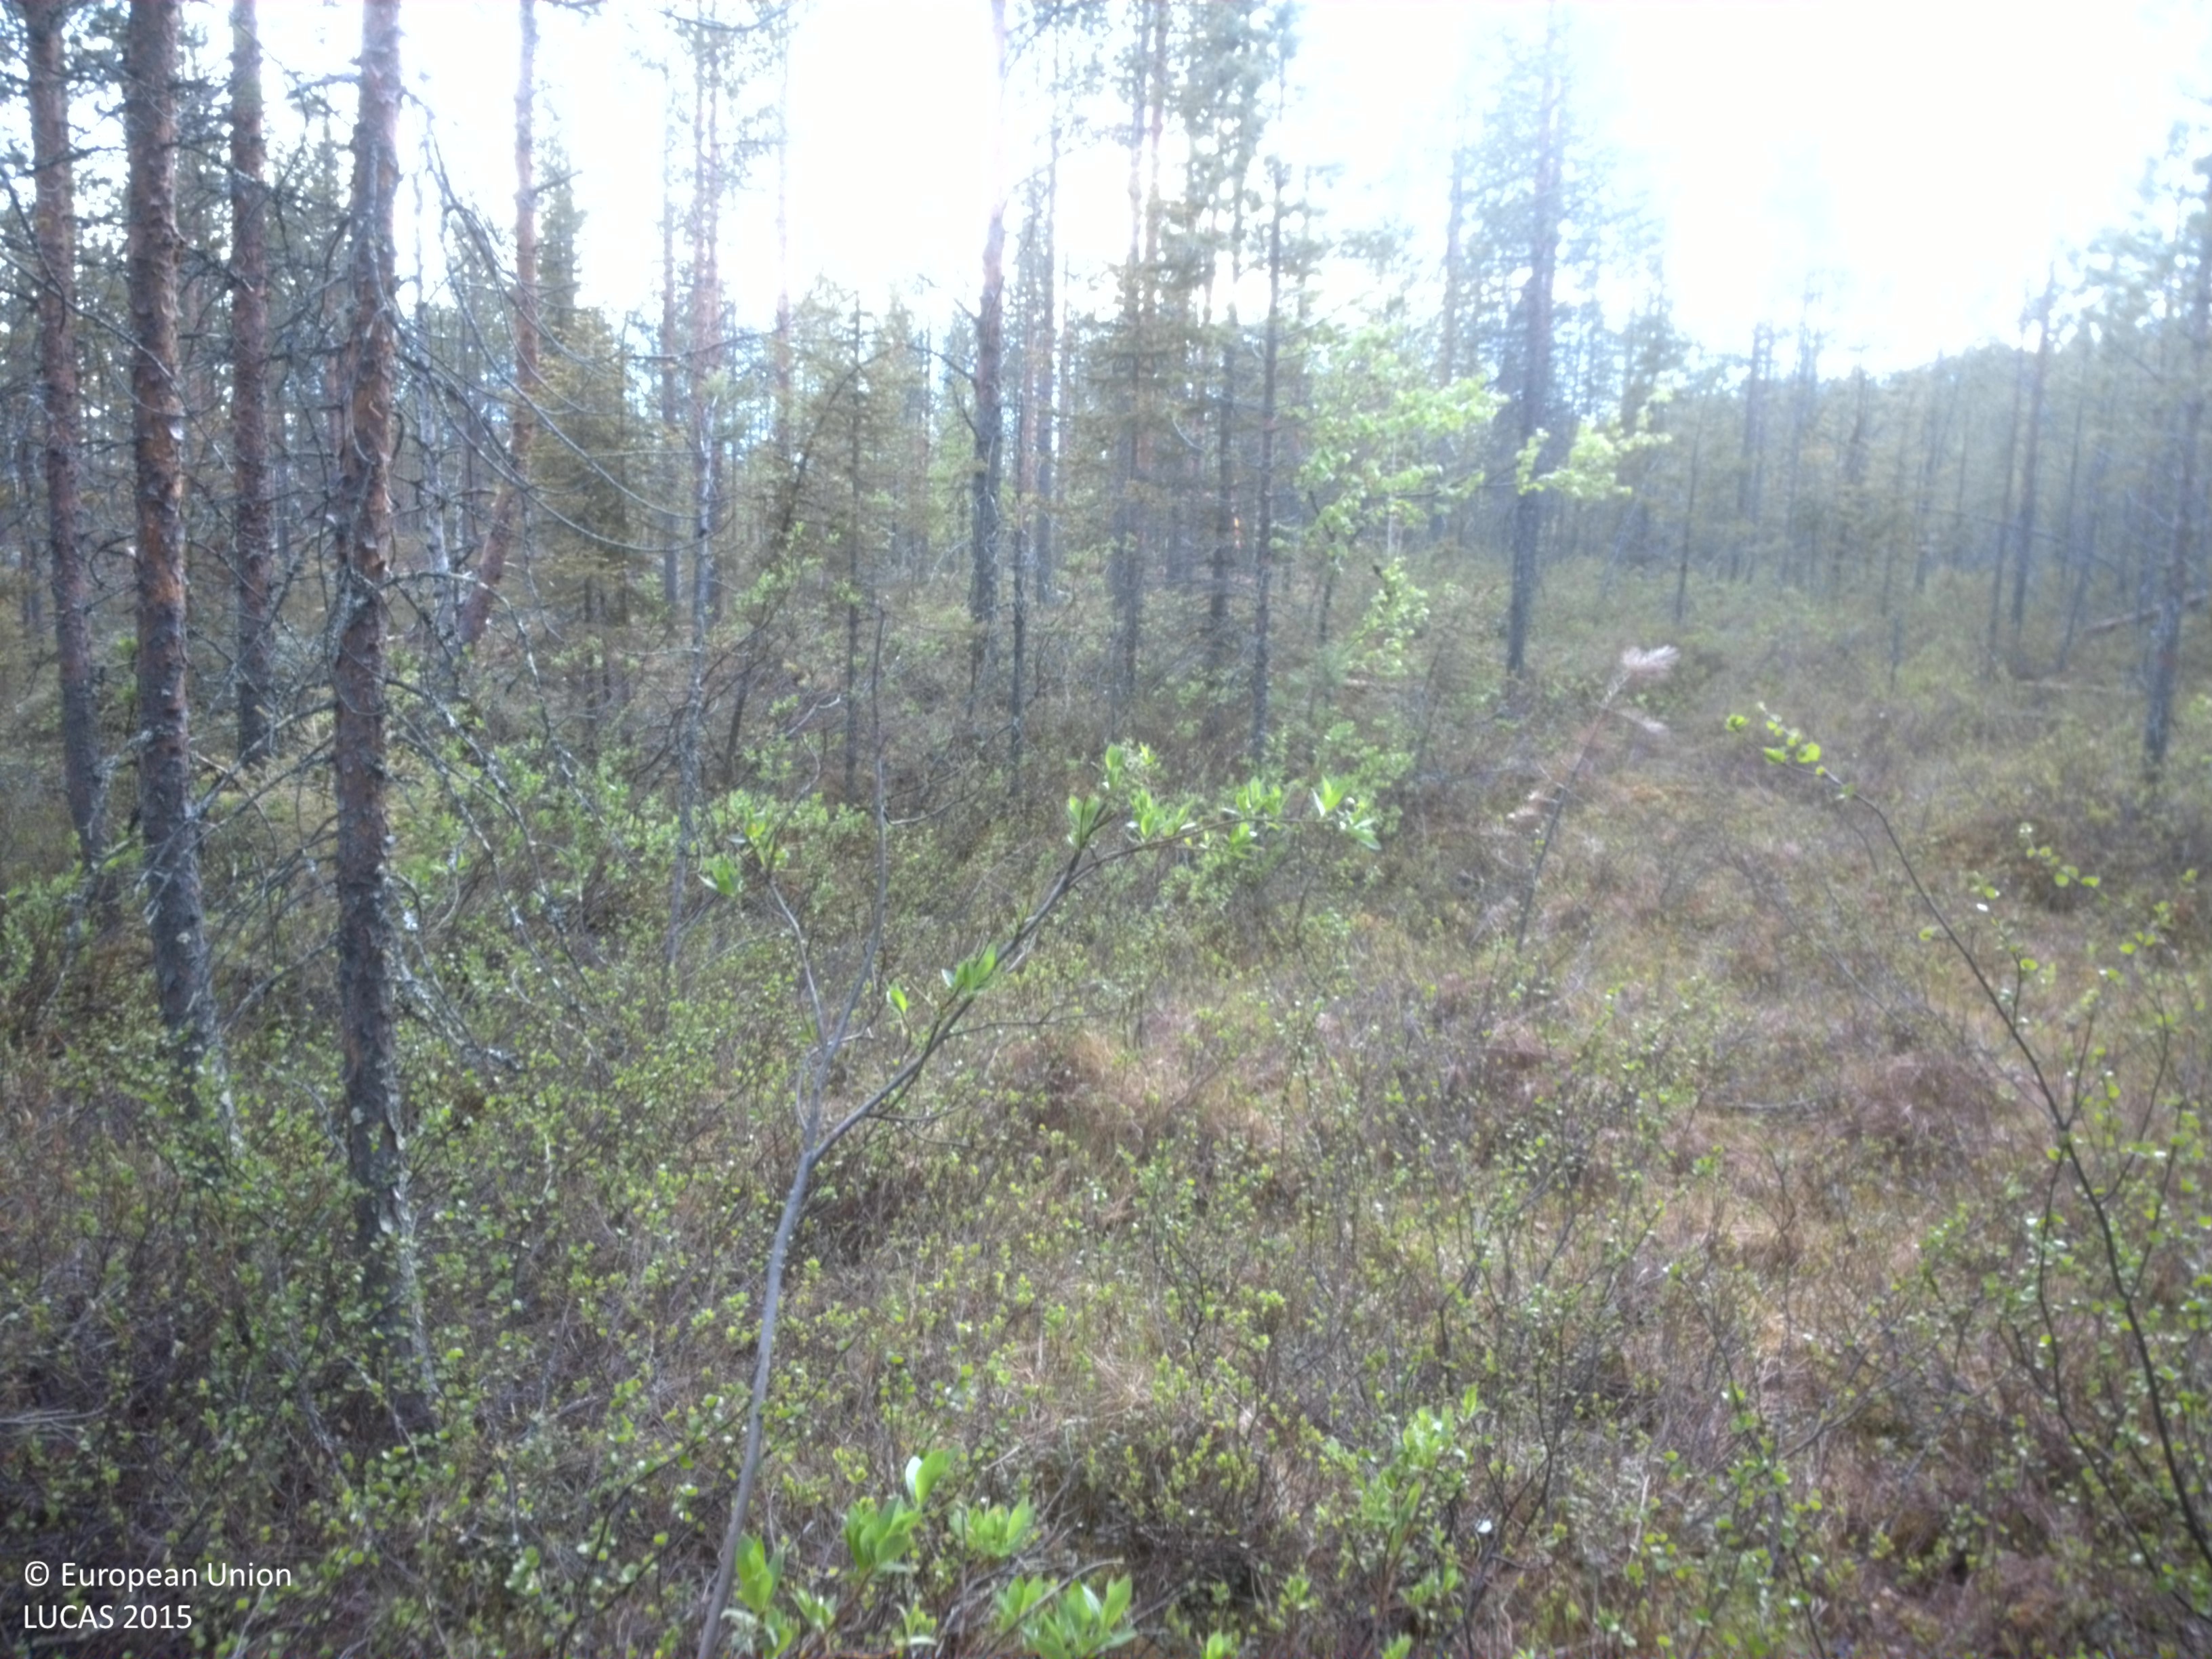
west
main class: Woodland
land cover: Pine dominated coniferous woodland
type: boreal forest
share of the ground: 25 - 50 %
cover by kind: shrubs 70 %, coniferous forest trees 20 %, broadleaved forest trees 5 %, lichens and mosses 5 %
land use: Forestry
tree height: > 5 m
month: June
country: SE
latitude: 66.9268
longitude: 21.7810
